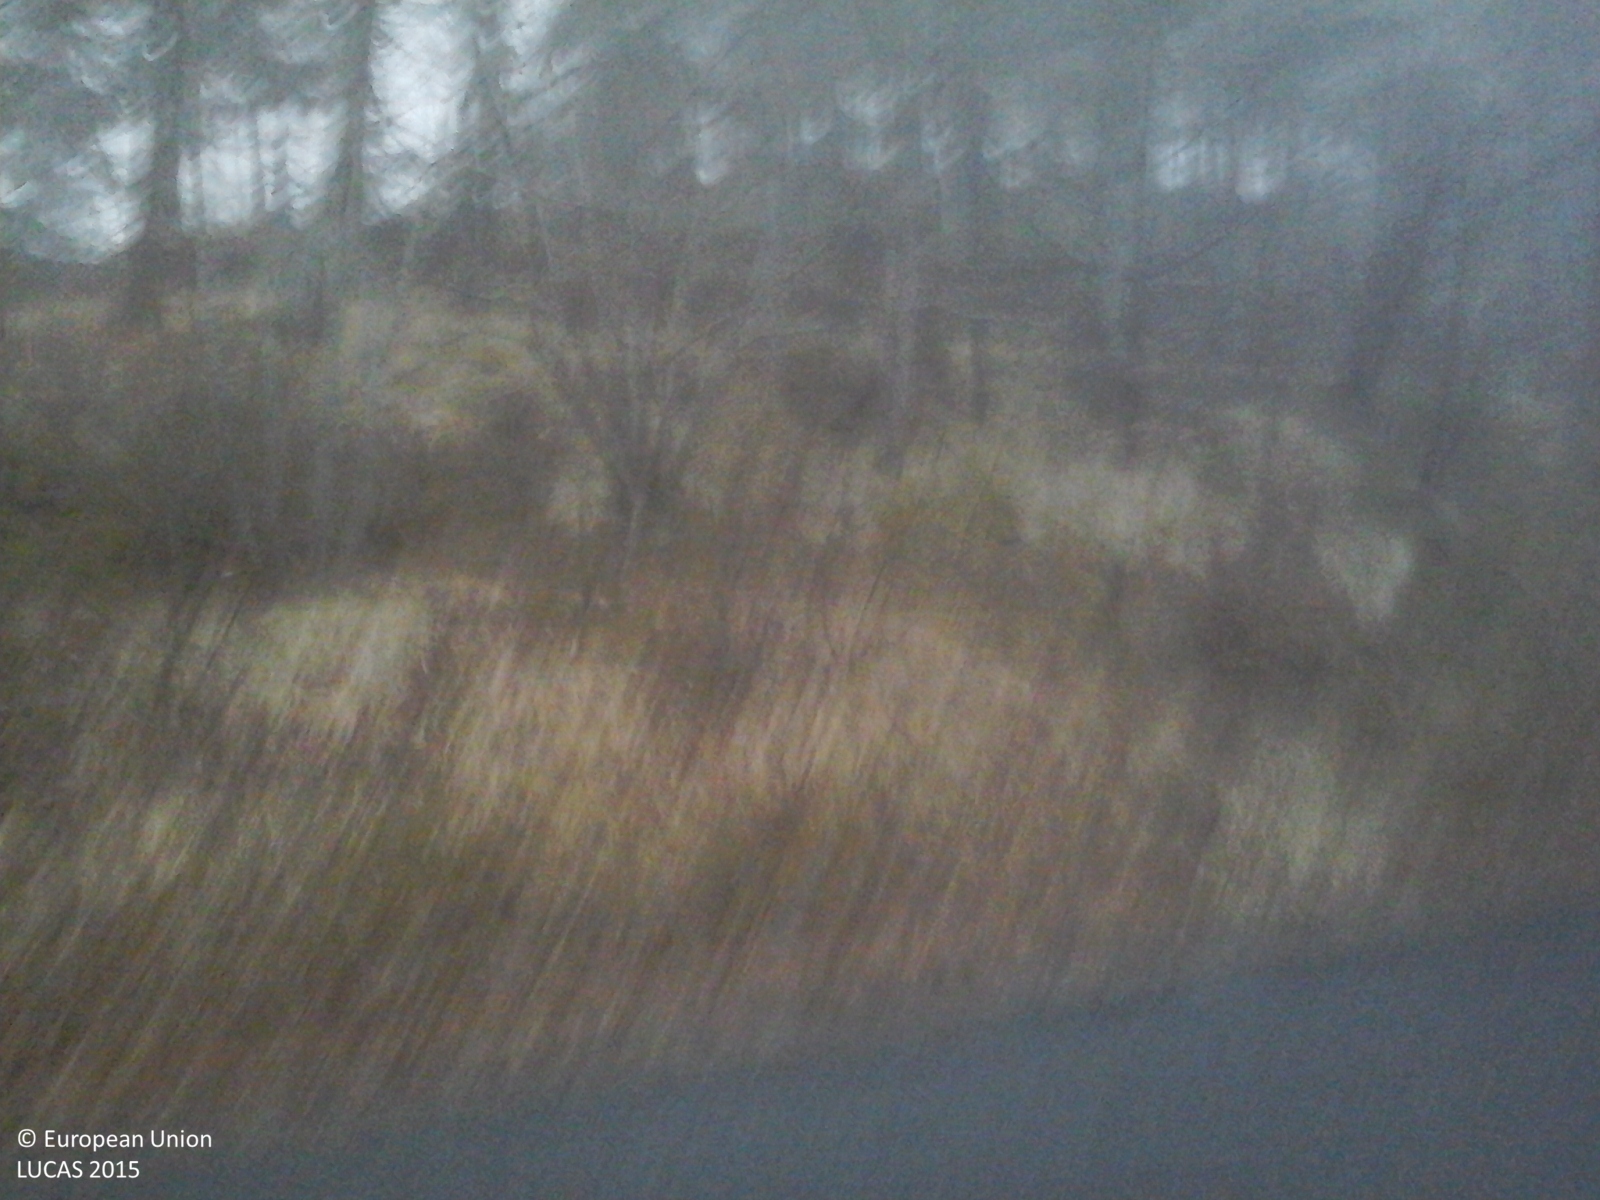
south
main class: Woodland
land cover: Broadleaved woodland
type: thermophilous deciduous forest
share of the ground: > 75 %
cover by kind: broadleaved forest trees 80 %, coniferous forest trees 20 %
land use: Forestry
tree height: > 5 m
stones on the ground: 10 - 25 %
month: January
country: IT
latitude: 44.0931
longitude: 7.8192
